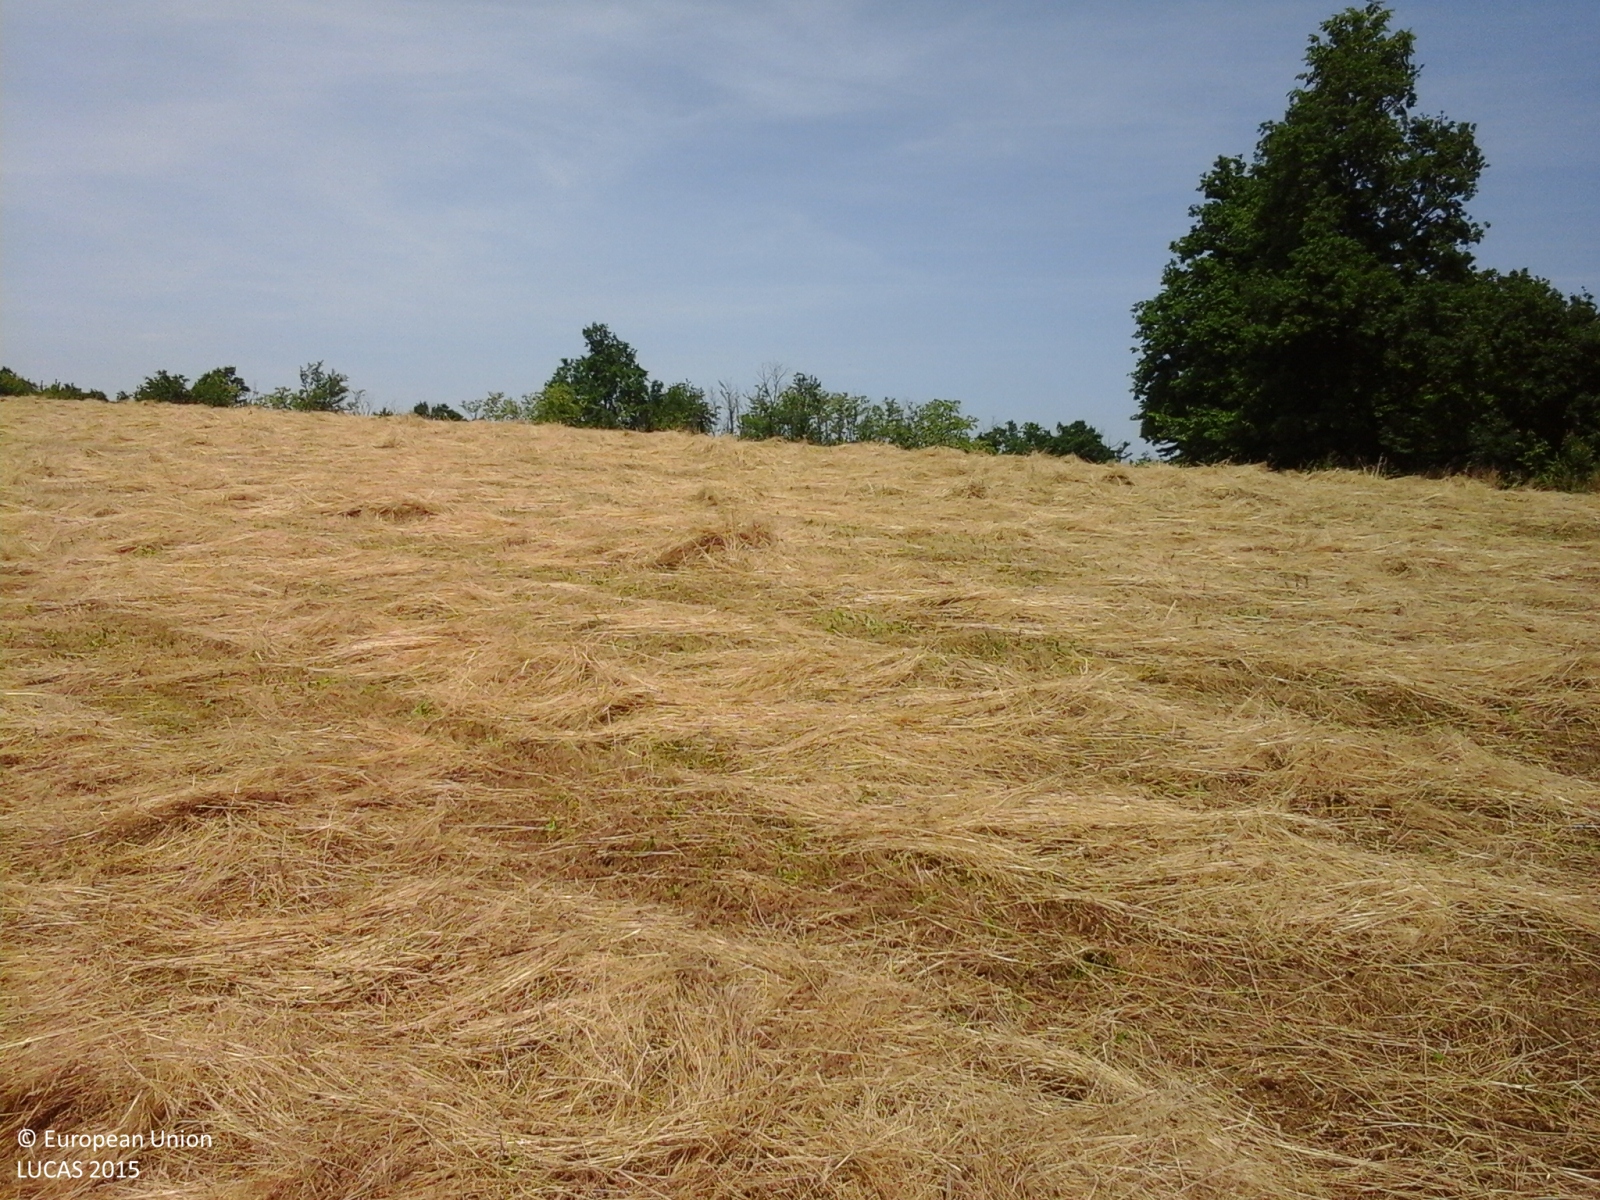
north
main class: Woodland
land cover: Broadleaved woodland
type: thermophilous deciduous forest
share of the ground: > 75 %
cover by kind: broadleaved forest trees 90 %, shrubs 10 %
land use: Forestry
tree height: < 5 m
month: May
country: IT
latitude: 44.8961
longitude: 8.3191
